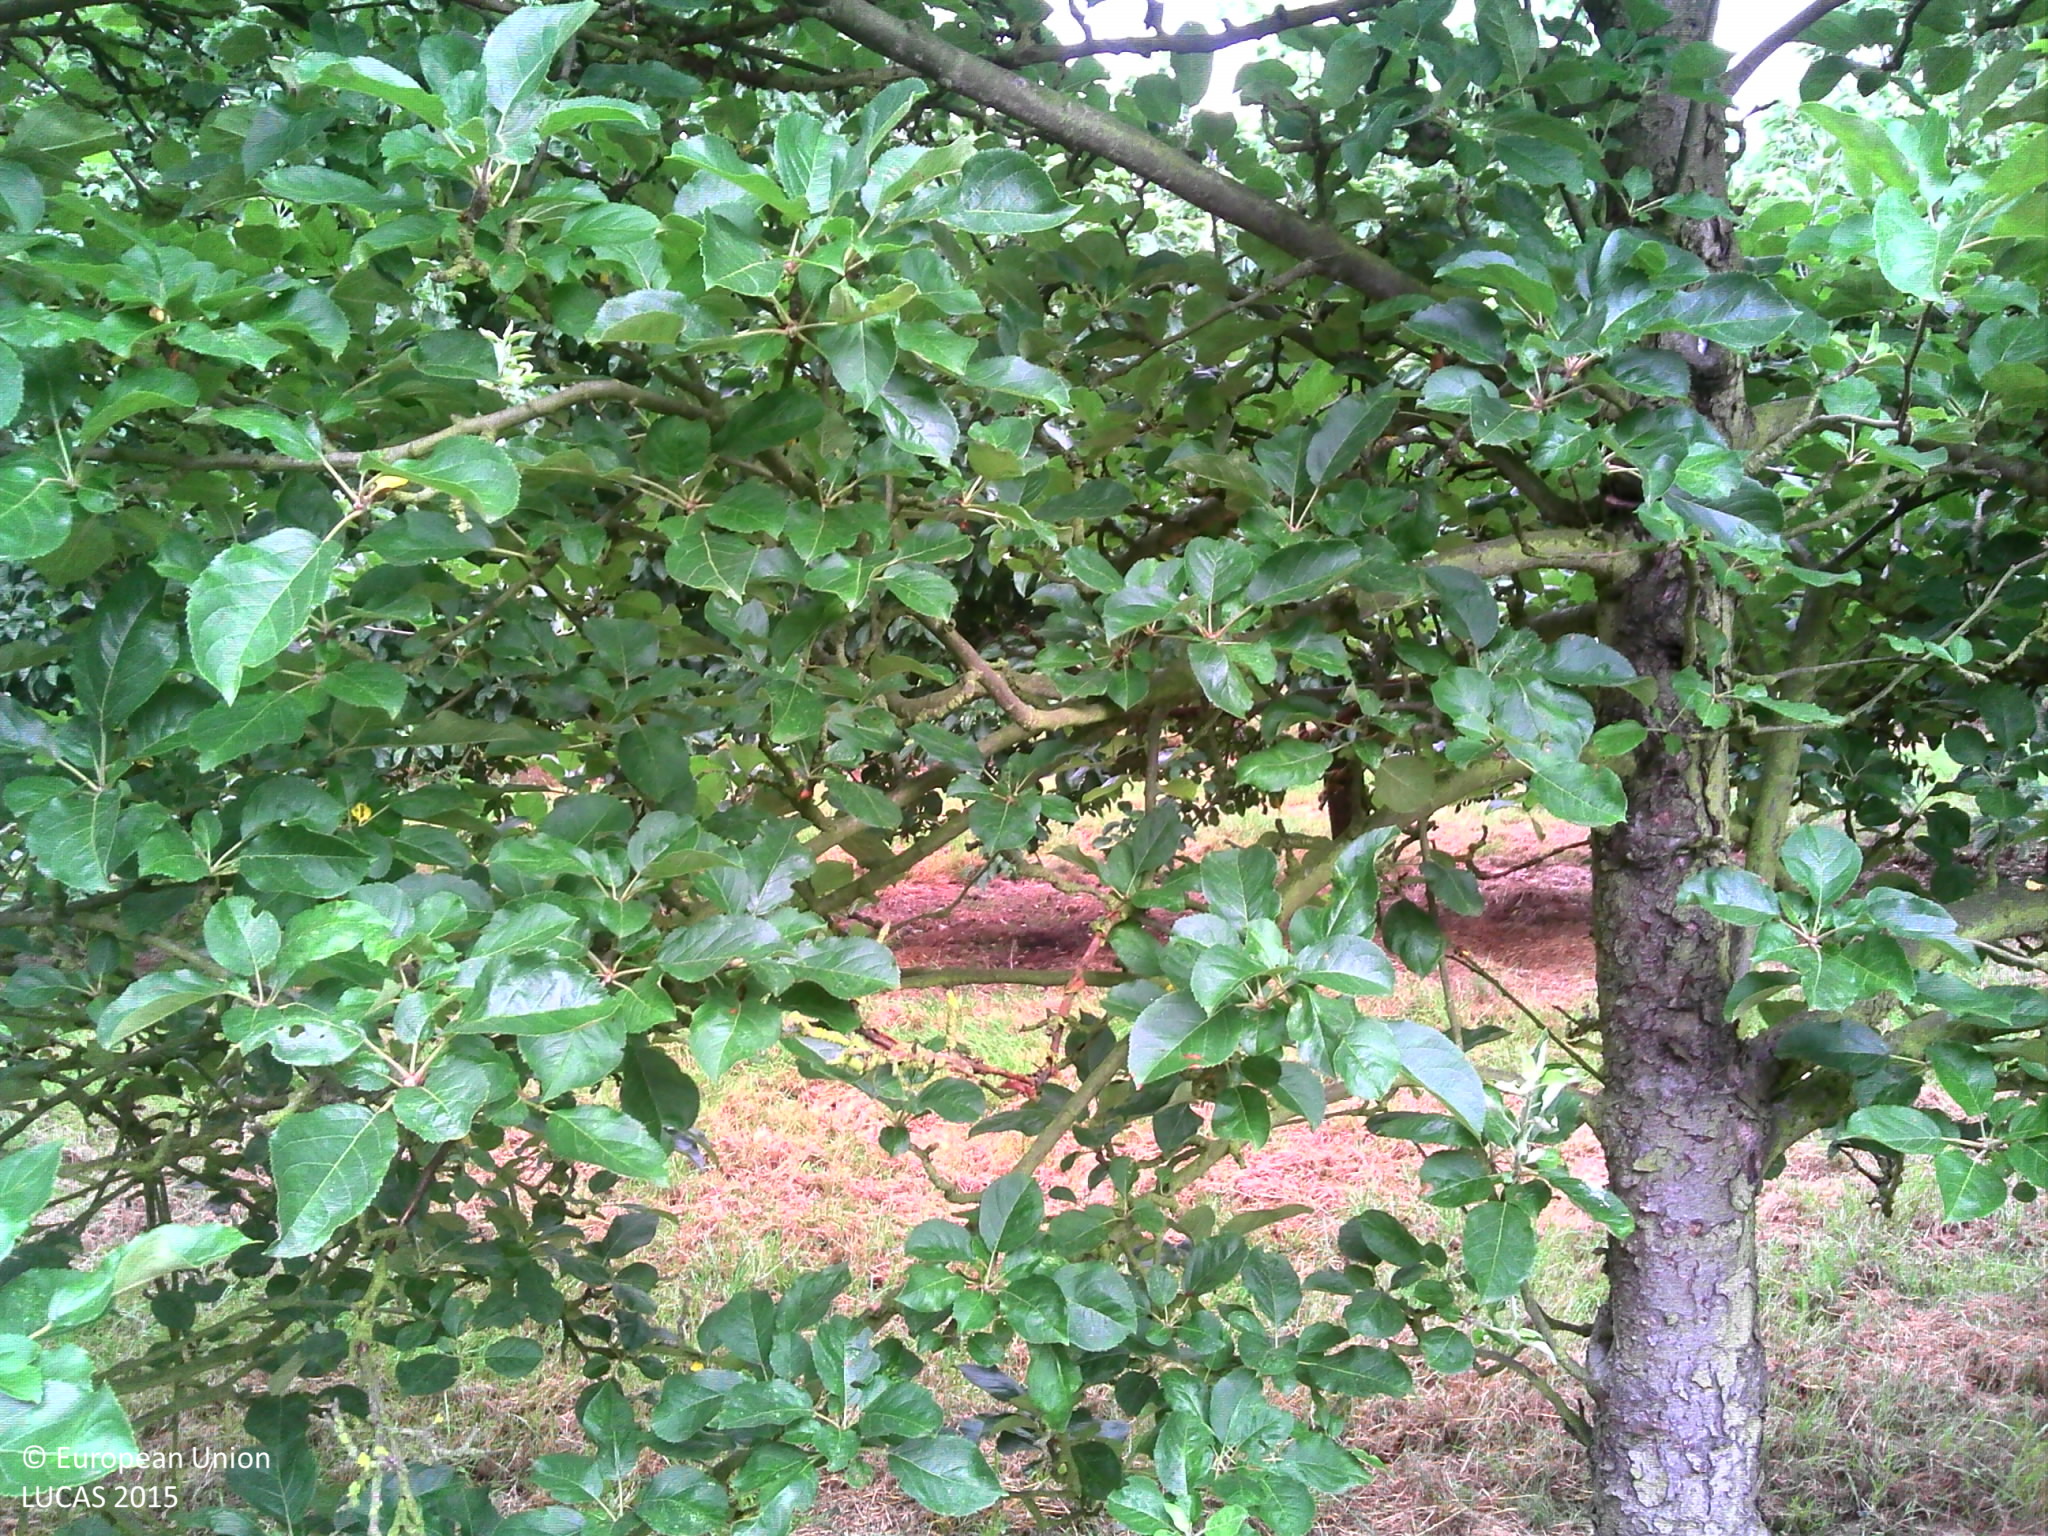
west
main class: Cropland
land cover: Apple fruit
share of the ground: 25 - 50 %
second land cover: Grassland without tree/shrub cover
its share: 50 - 75 %
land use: Agriculture (excluding fallow land and kitchen gardens)
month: July
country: FR
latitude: 48.5606
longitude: -2.2117
